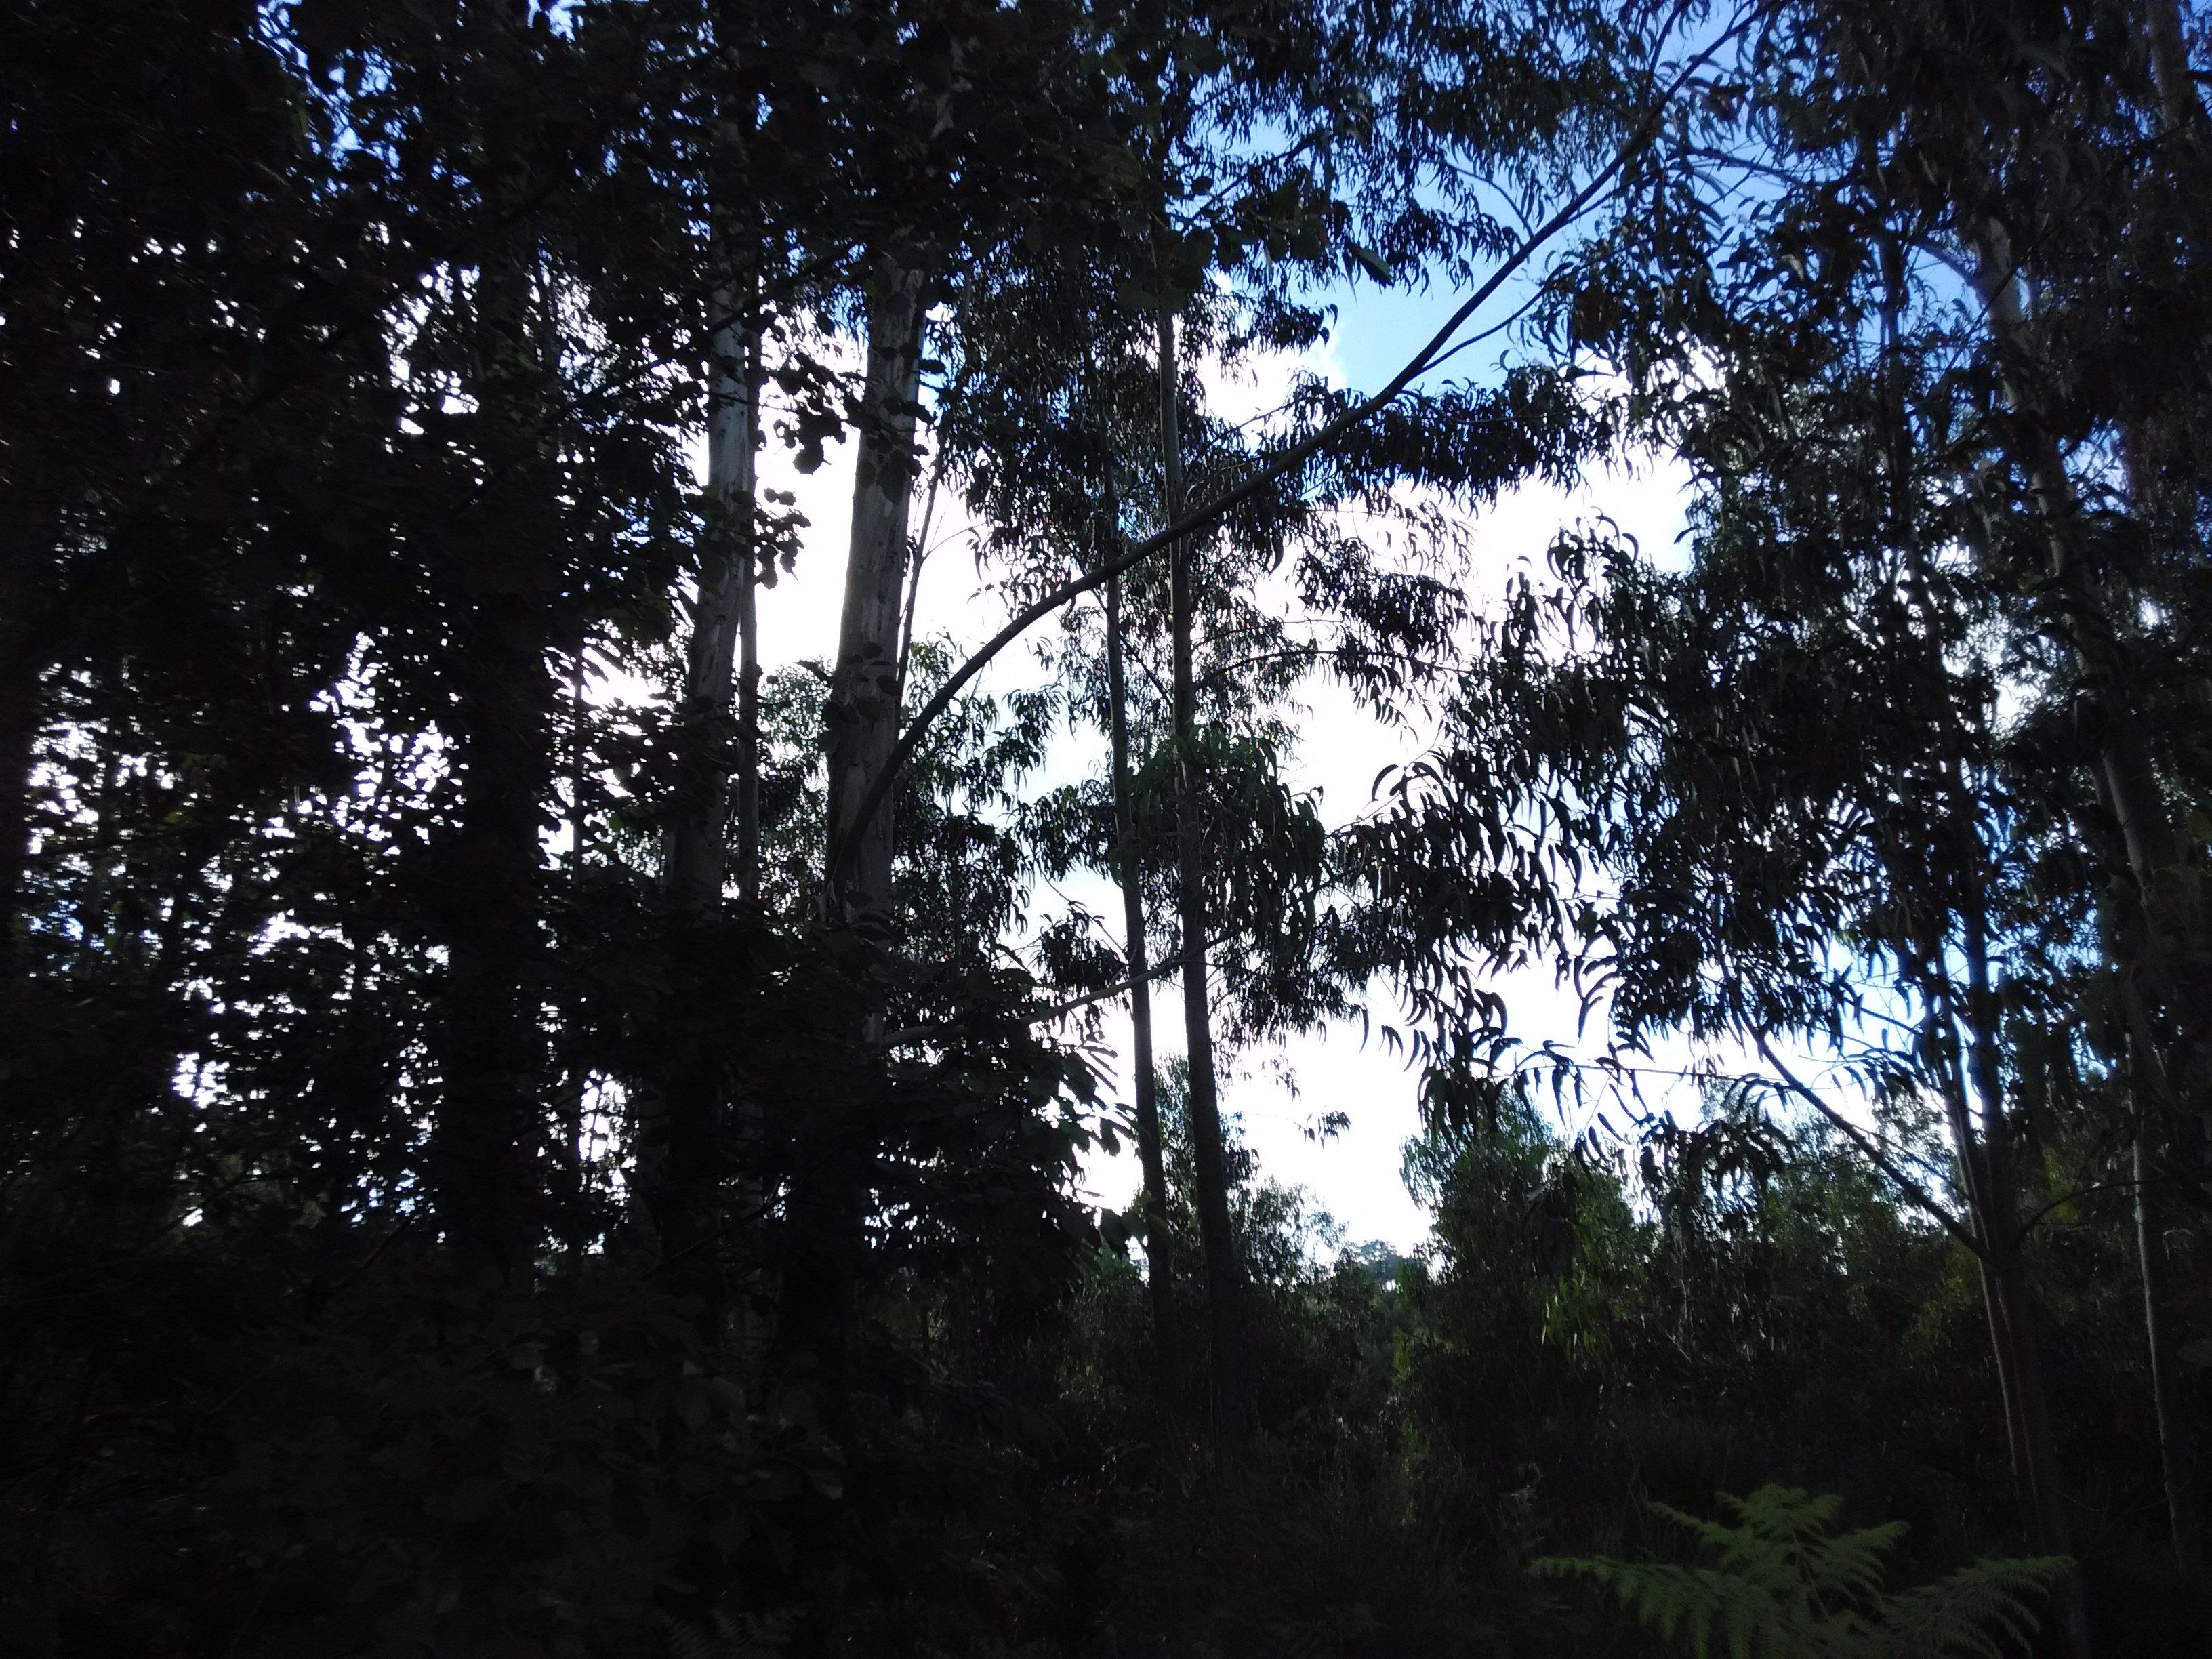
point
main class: Woodland
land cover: Broadleaved woodland
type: exotic forest
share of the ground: > 75 %
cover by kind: broadleaved forest trees 90 %, shrubs 10 %
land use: Forestry
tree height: > 5 m
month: June
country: ES
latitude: 43.3392
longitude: -2.4745
